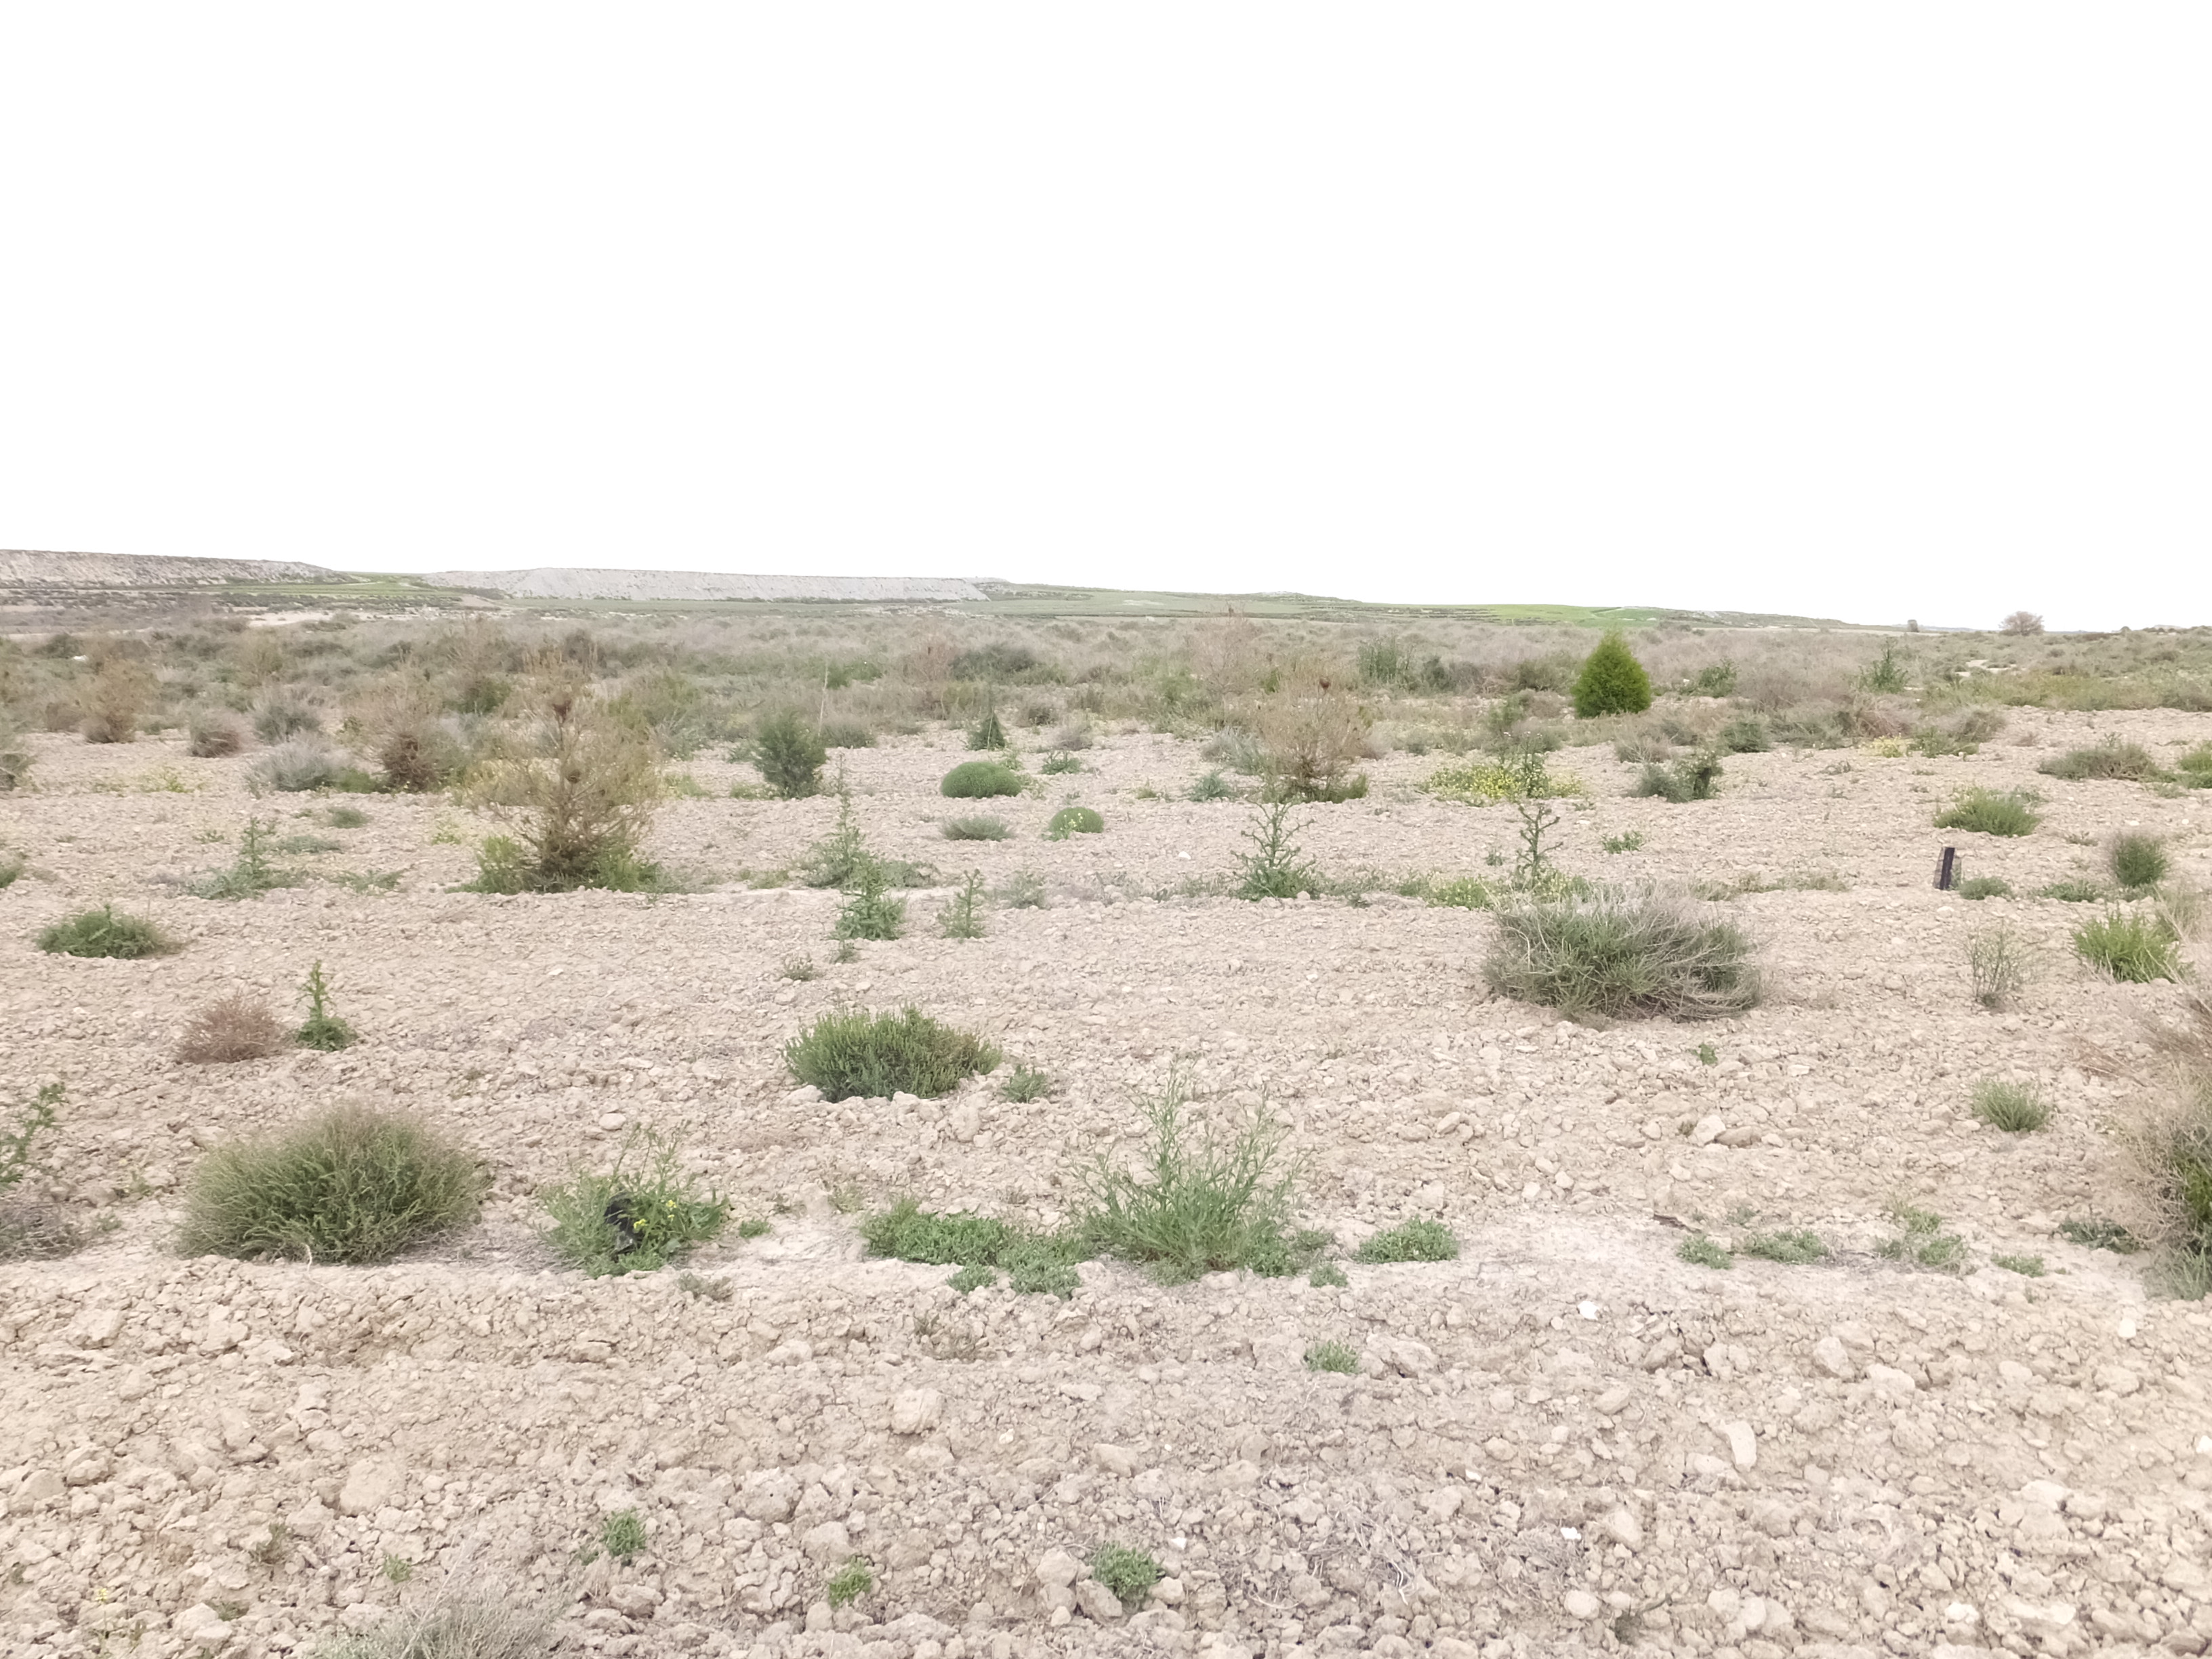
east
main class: Shrubland
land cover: Shrubland with sparse tree cover
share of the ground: 25 - 50 %
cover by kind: unconsolidated bare surface 55 %, shrubs 40 %, coniferous forest trees 5 %
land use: Forestry
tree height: < 5 m
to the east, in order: Shrubland with sparse tree cover; Shruby margins; Tracks; Shruby margins; Shrubland without tree cover; Grass margins; Other bare soil
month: April
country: ES
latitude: 41.5406
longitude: -0.1689
